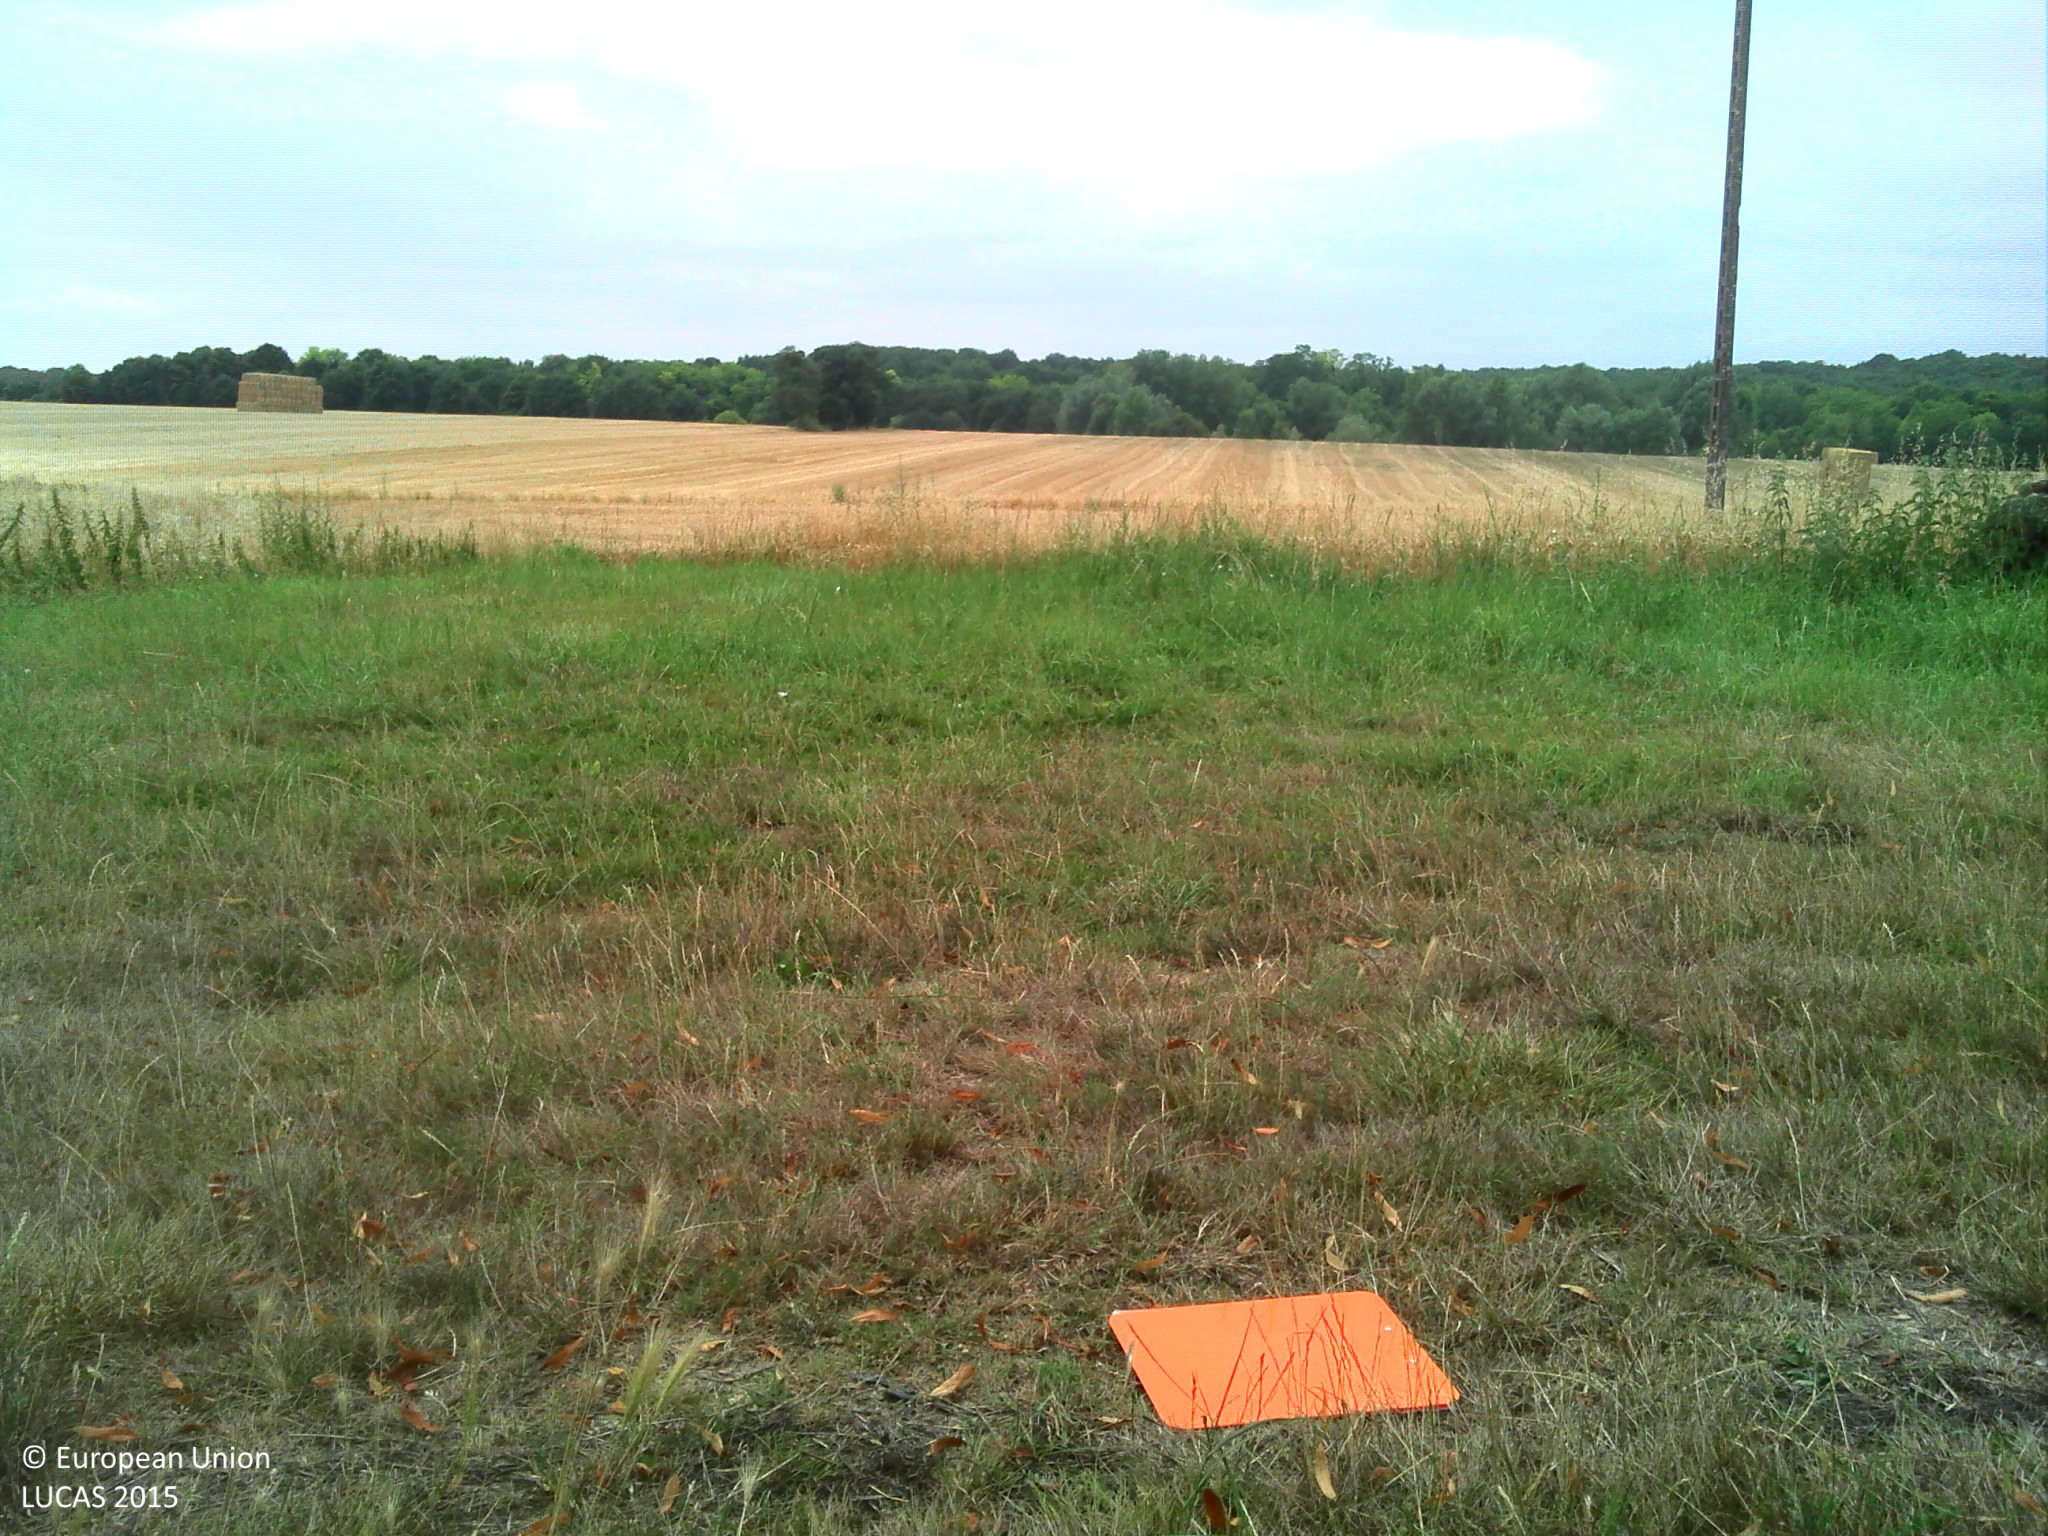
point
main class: Grassland
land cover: Grassland without tree/shrub cover
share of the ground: > 75 %
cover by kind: herbaceous plants 100 %
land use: Agriculture (excluding fallow land and kitchen gardens)
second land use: Residential
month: July
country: FR
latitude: 47.3265
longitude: 0.3318
